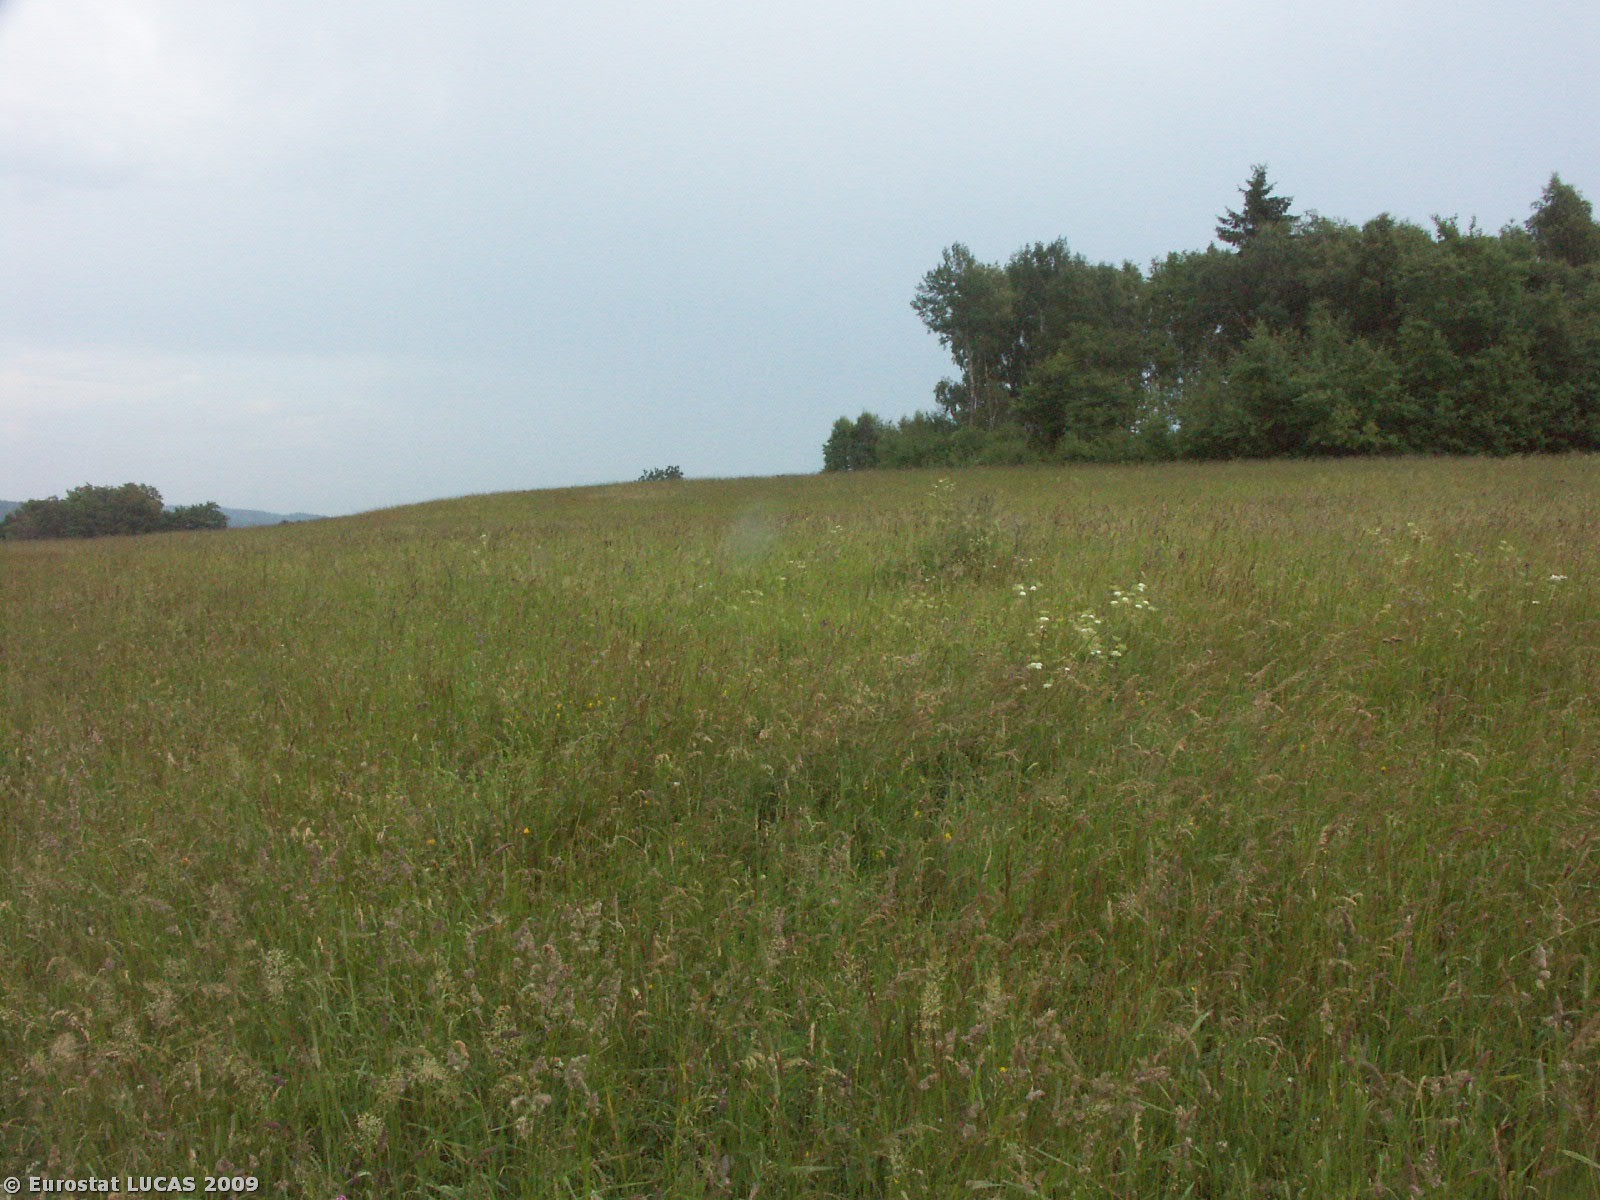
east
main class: Grassland
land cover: Grassland without tree/shrub cover
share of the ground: > 75 %
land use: Agriculture (excluding fallow land and kitchen gardens)
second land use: Nature reserves
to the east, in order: Grassland without tree/shrub cover; Broadleaved woodland; Grassland without tree/shrub cover
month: June
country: CZ
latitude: 49.9554
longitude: 17.2169
